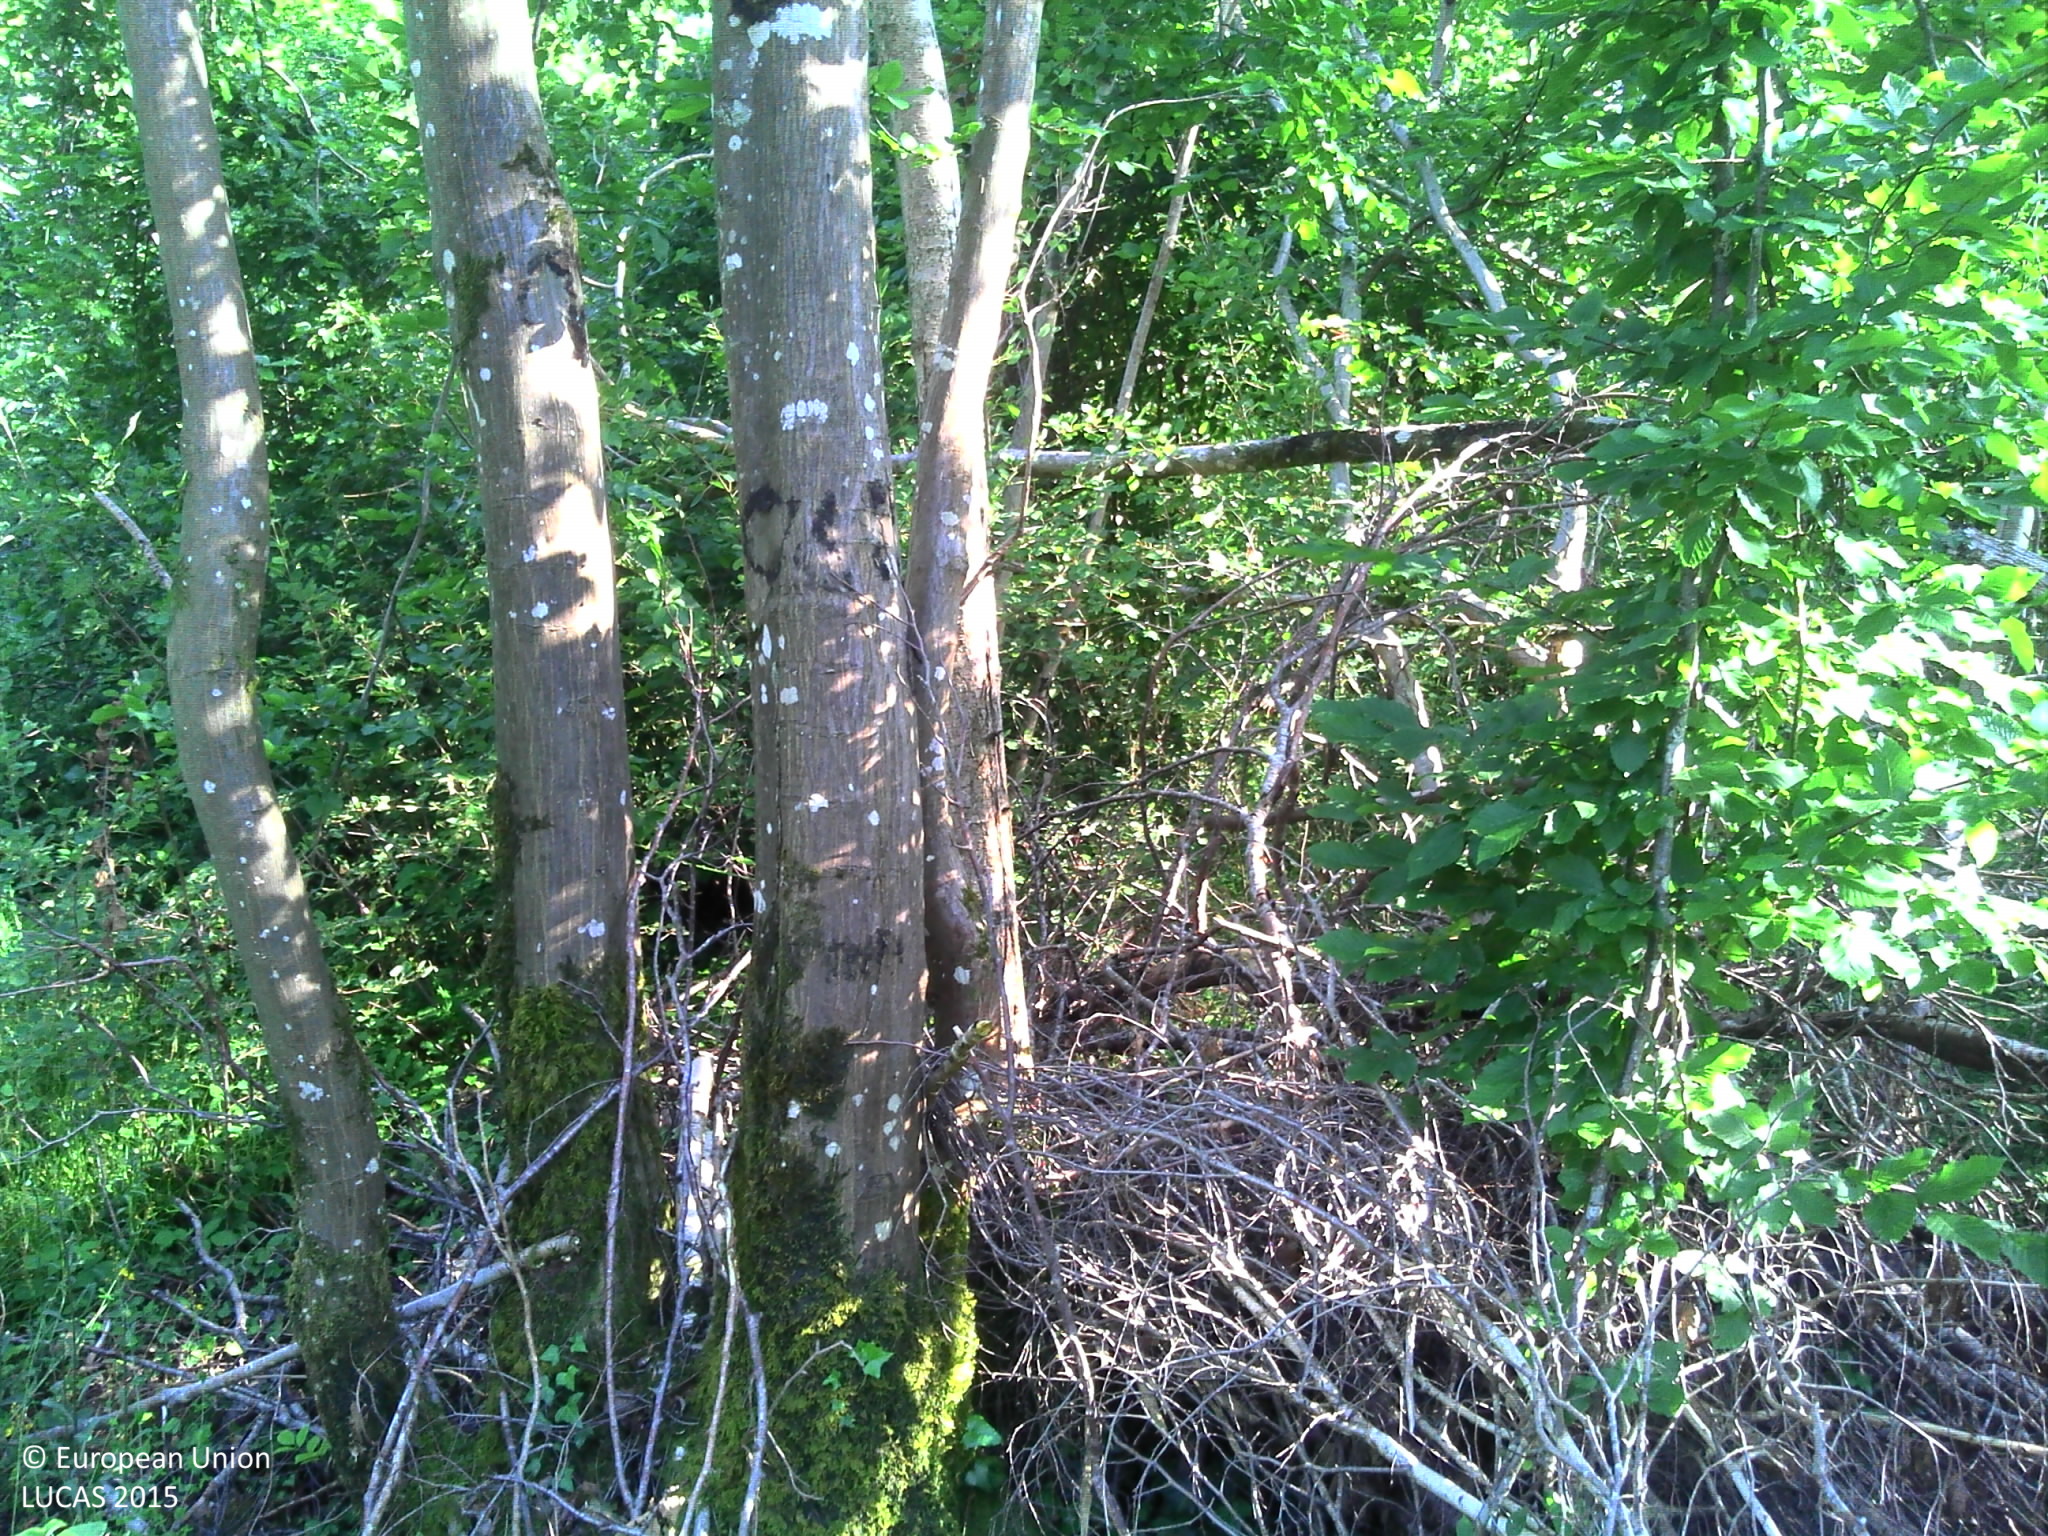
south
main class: Woodland
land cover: Broadleaved woodland
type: acidophilous oak and oak-birch forest
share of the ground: > 75 %
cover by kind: broadleaved forest trees 95 %, lichens and mosses 5 %
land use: Forestry
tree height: > 5 m
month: June
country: FR
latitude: 48.5452
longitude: 0.1785
